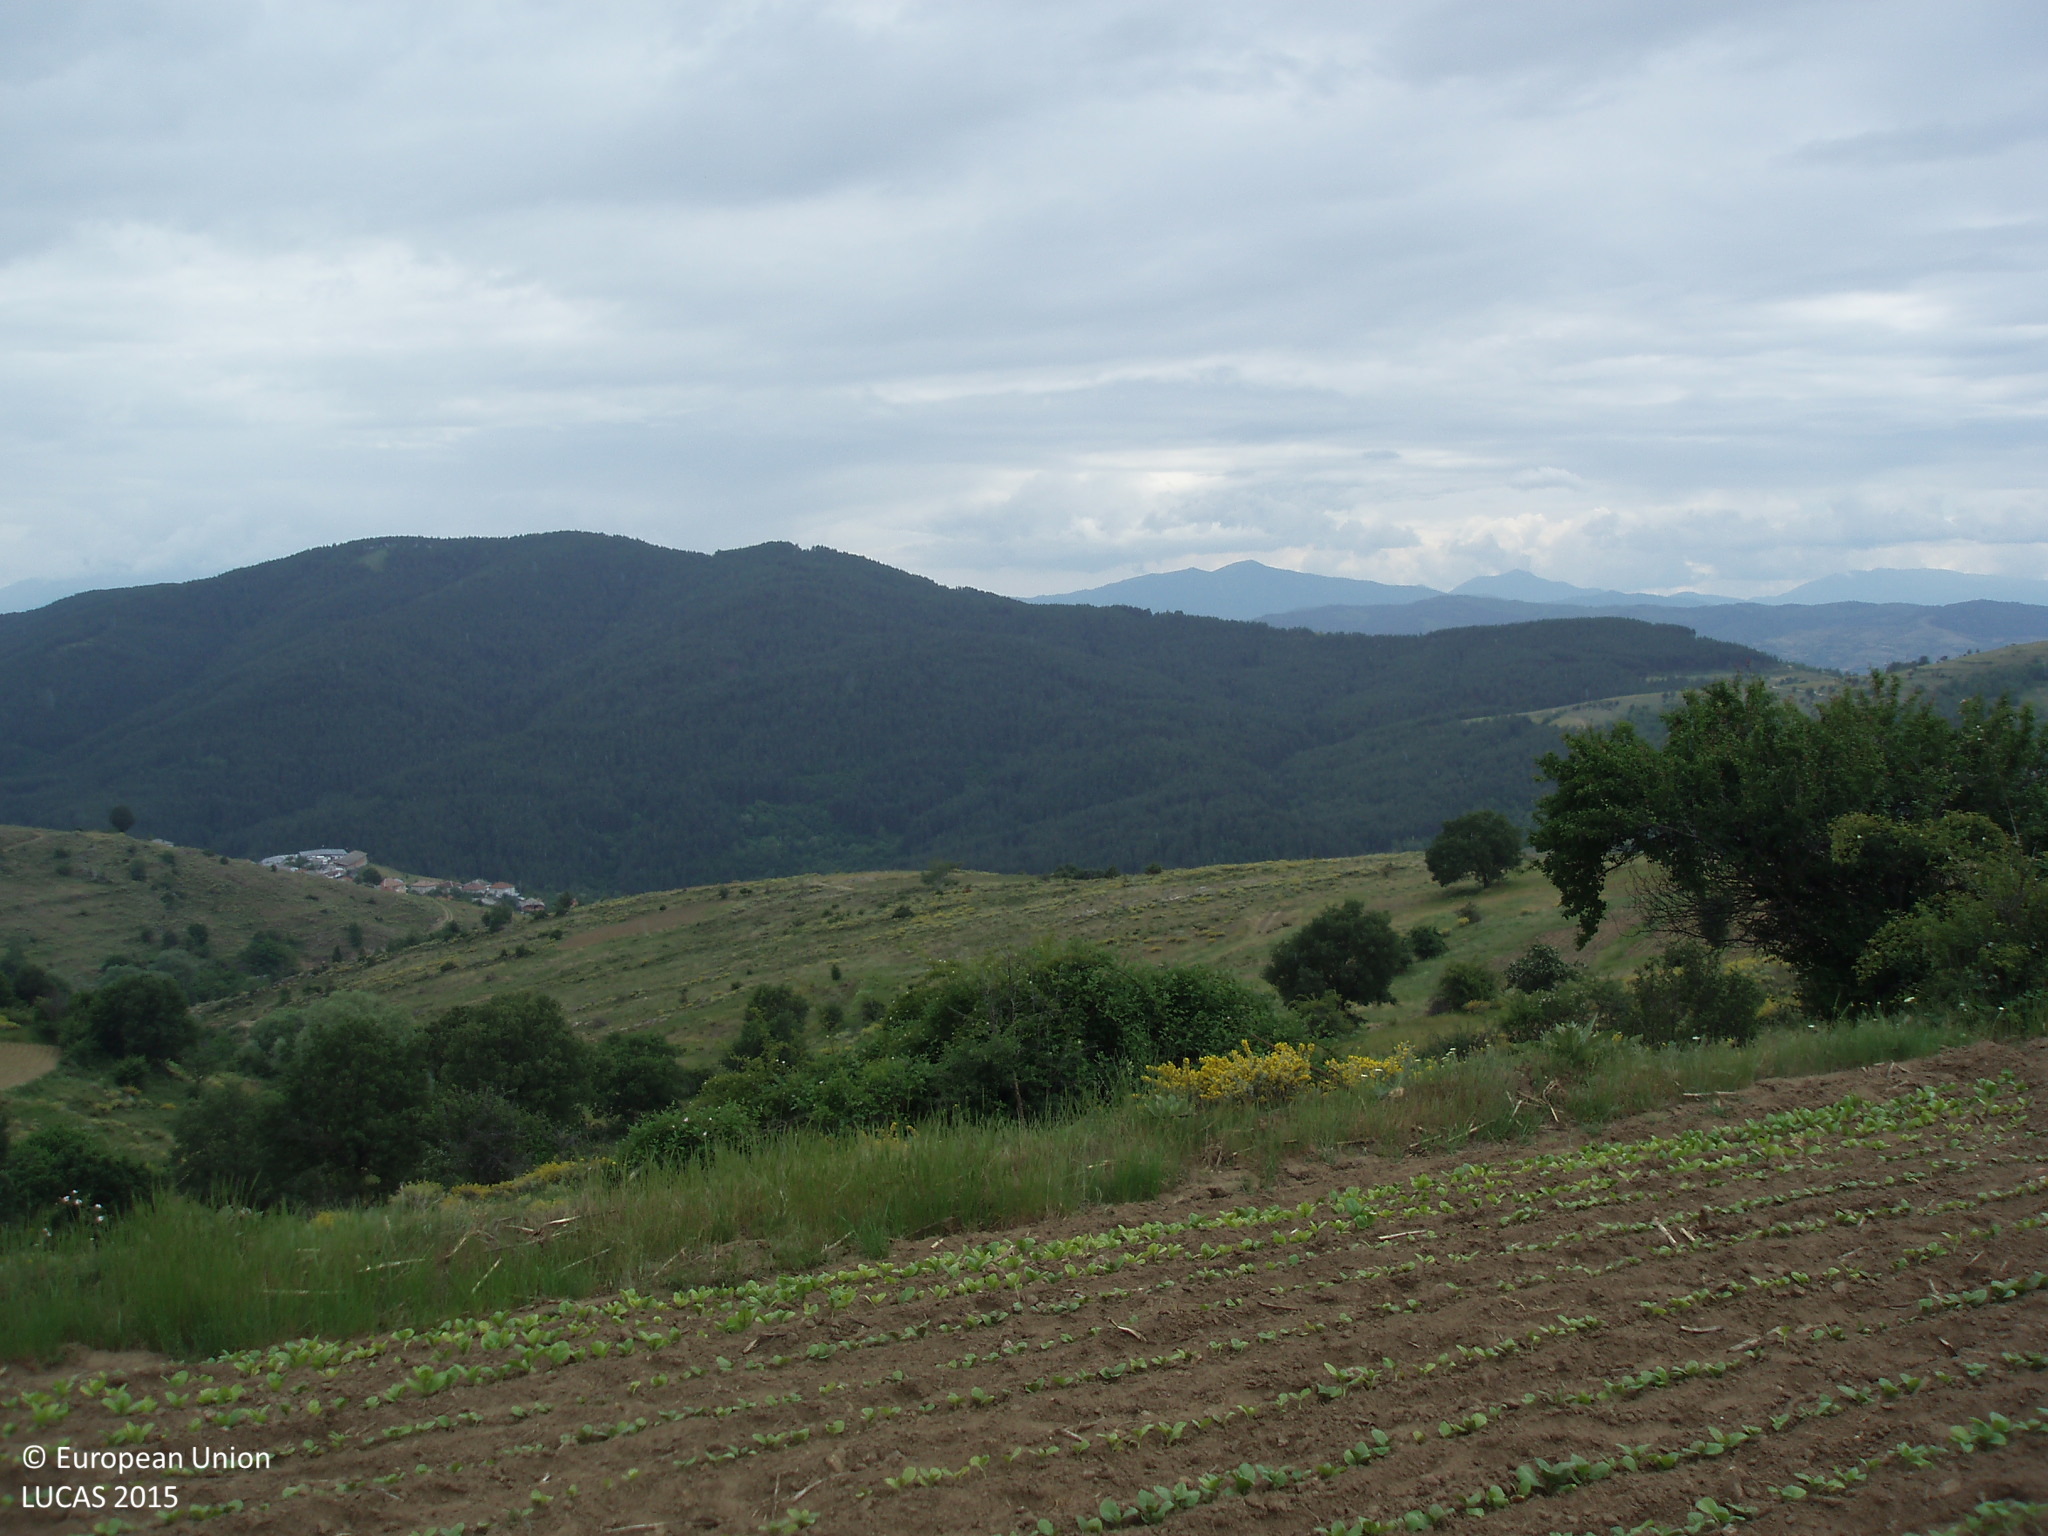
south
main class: Cropland
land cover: Tobacco
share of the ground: 25 - 50 %
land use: Agriculture (excluding fallow land and kitchen gardens)
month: June
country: BG
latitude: 41.5627
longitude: 24.0261
